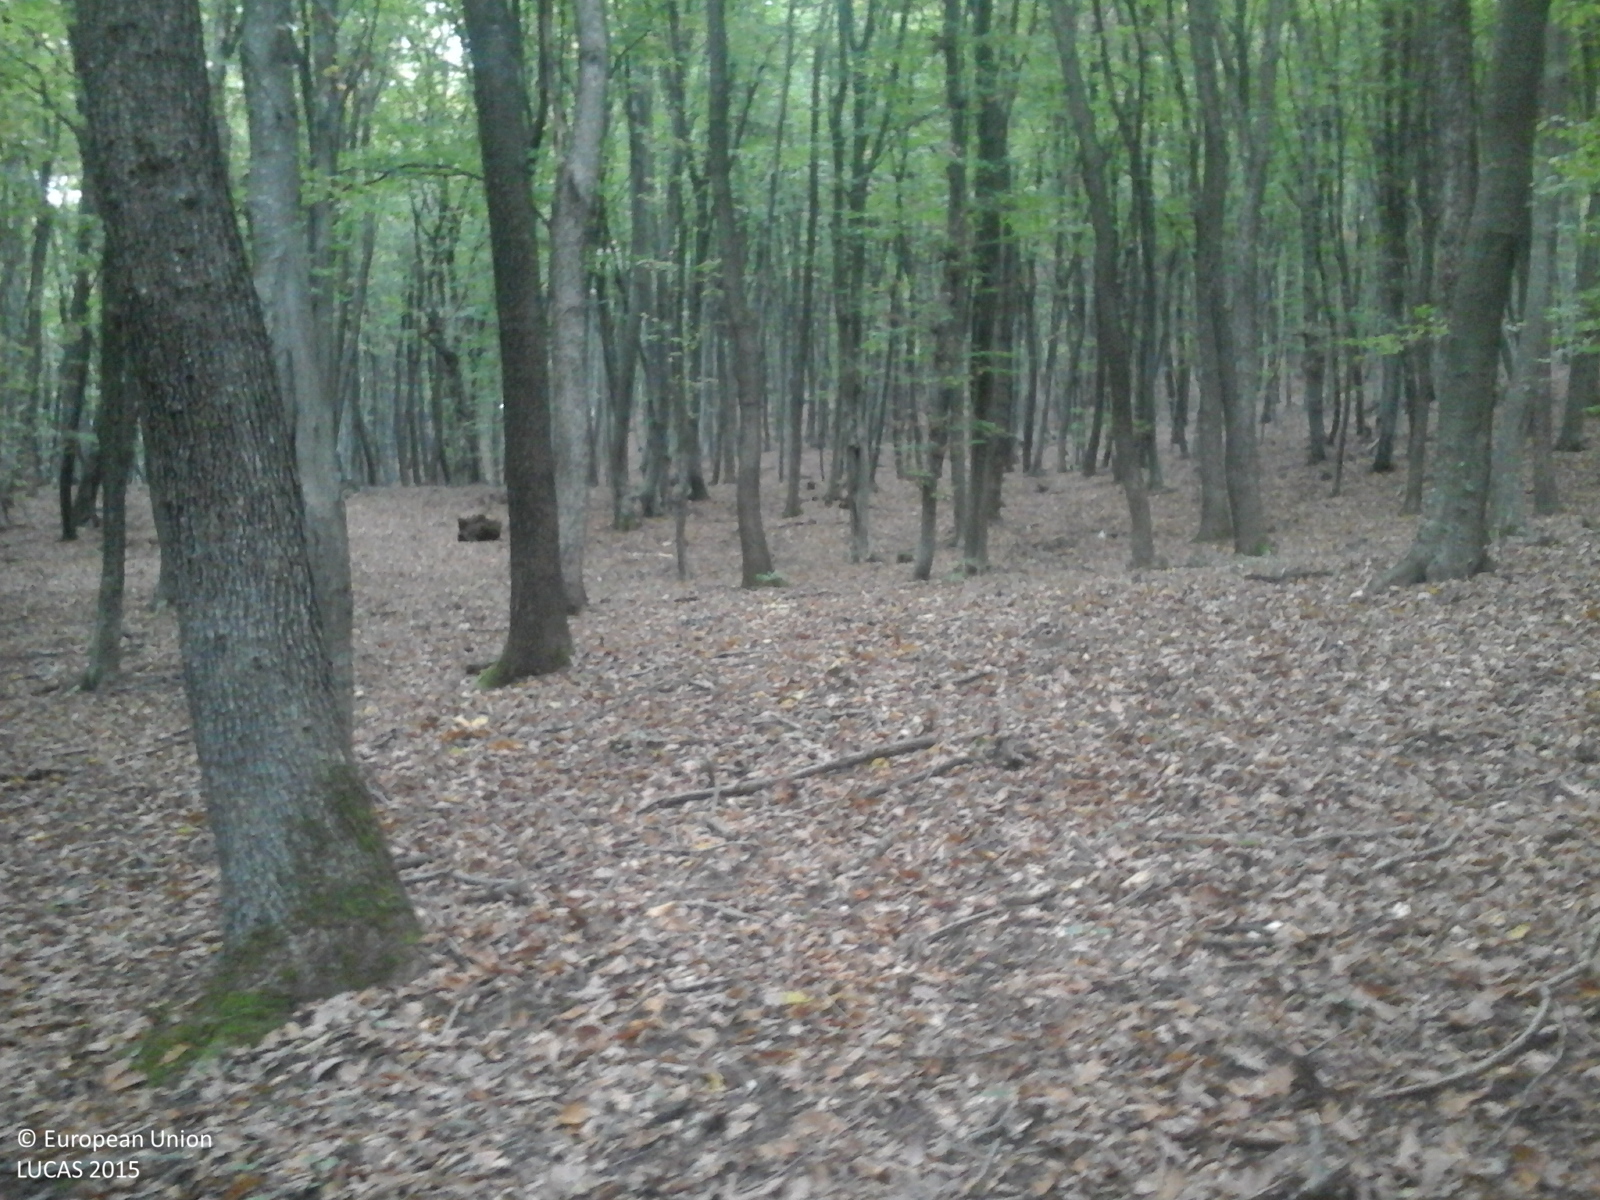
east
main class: Woodland
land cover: Broadleaved woodland
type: acidophilous oak and oak-birch forest
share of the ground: > 75 %
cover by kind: broadleaved forest trees 100 %
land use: Forestry
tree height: > 5 m
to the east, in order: Broadleaved woodland
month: October
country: RO
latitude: 46.1333
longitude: 24.8338
